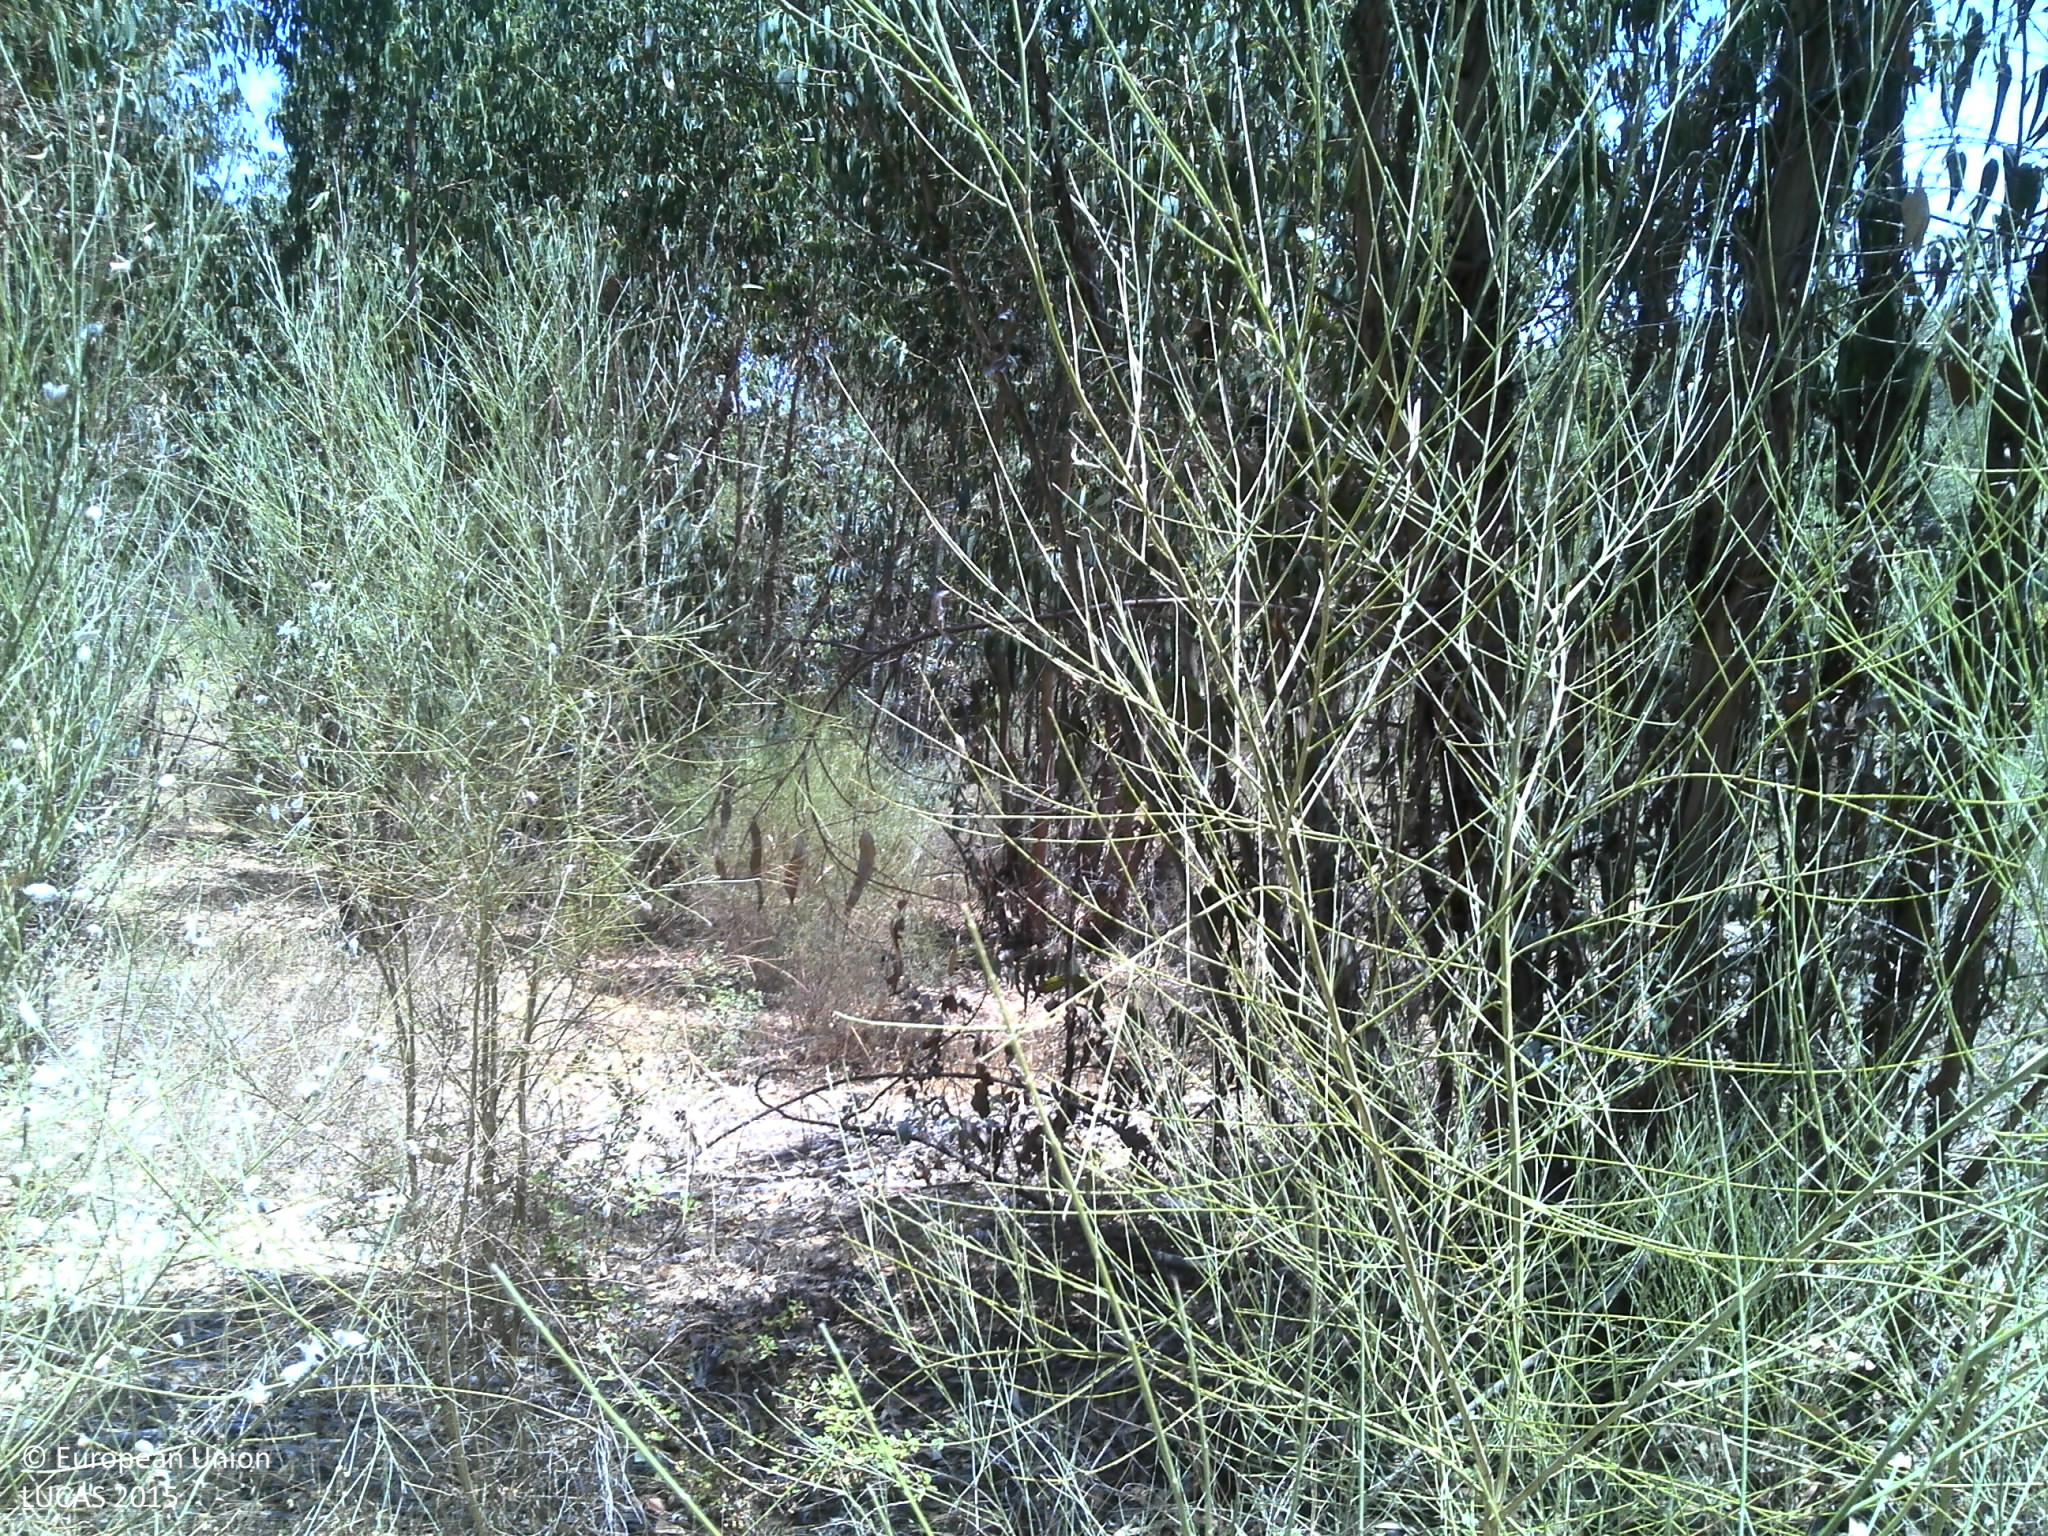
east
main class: Woodland
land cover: Broadleaved woodland
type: exotic forest
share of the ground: 25 - 50 %
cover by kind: shrubs 70 %, broadleaved forest trees 30 %
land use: Forestry
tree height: > 5 m
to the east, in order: Broadleaved woodland; Rivers and streams; Broadleaved woodland; Rocks and stones; Shrubland without tree cover; Rocks and stones; Rivers and streams; Broadleaved woodland
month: July
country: PT
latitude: 39.3107
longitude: -7.6878
